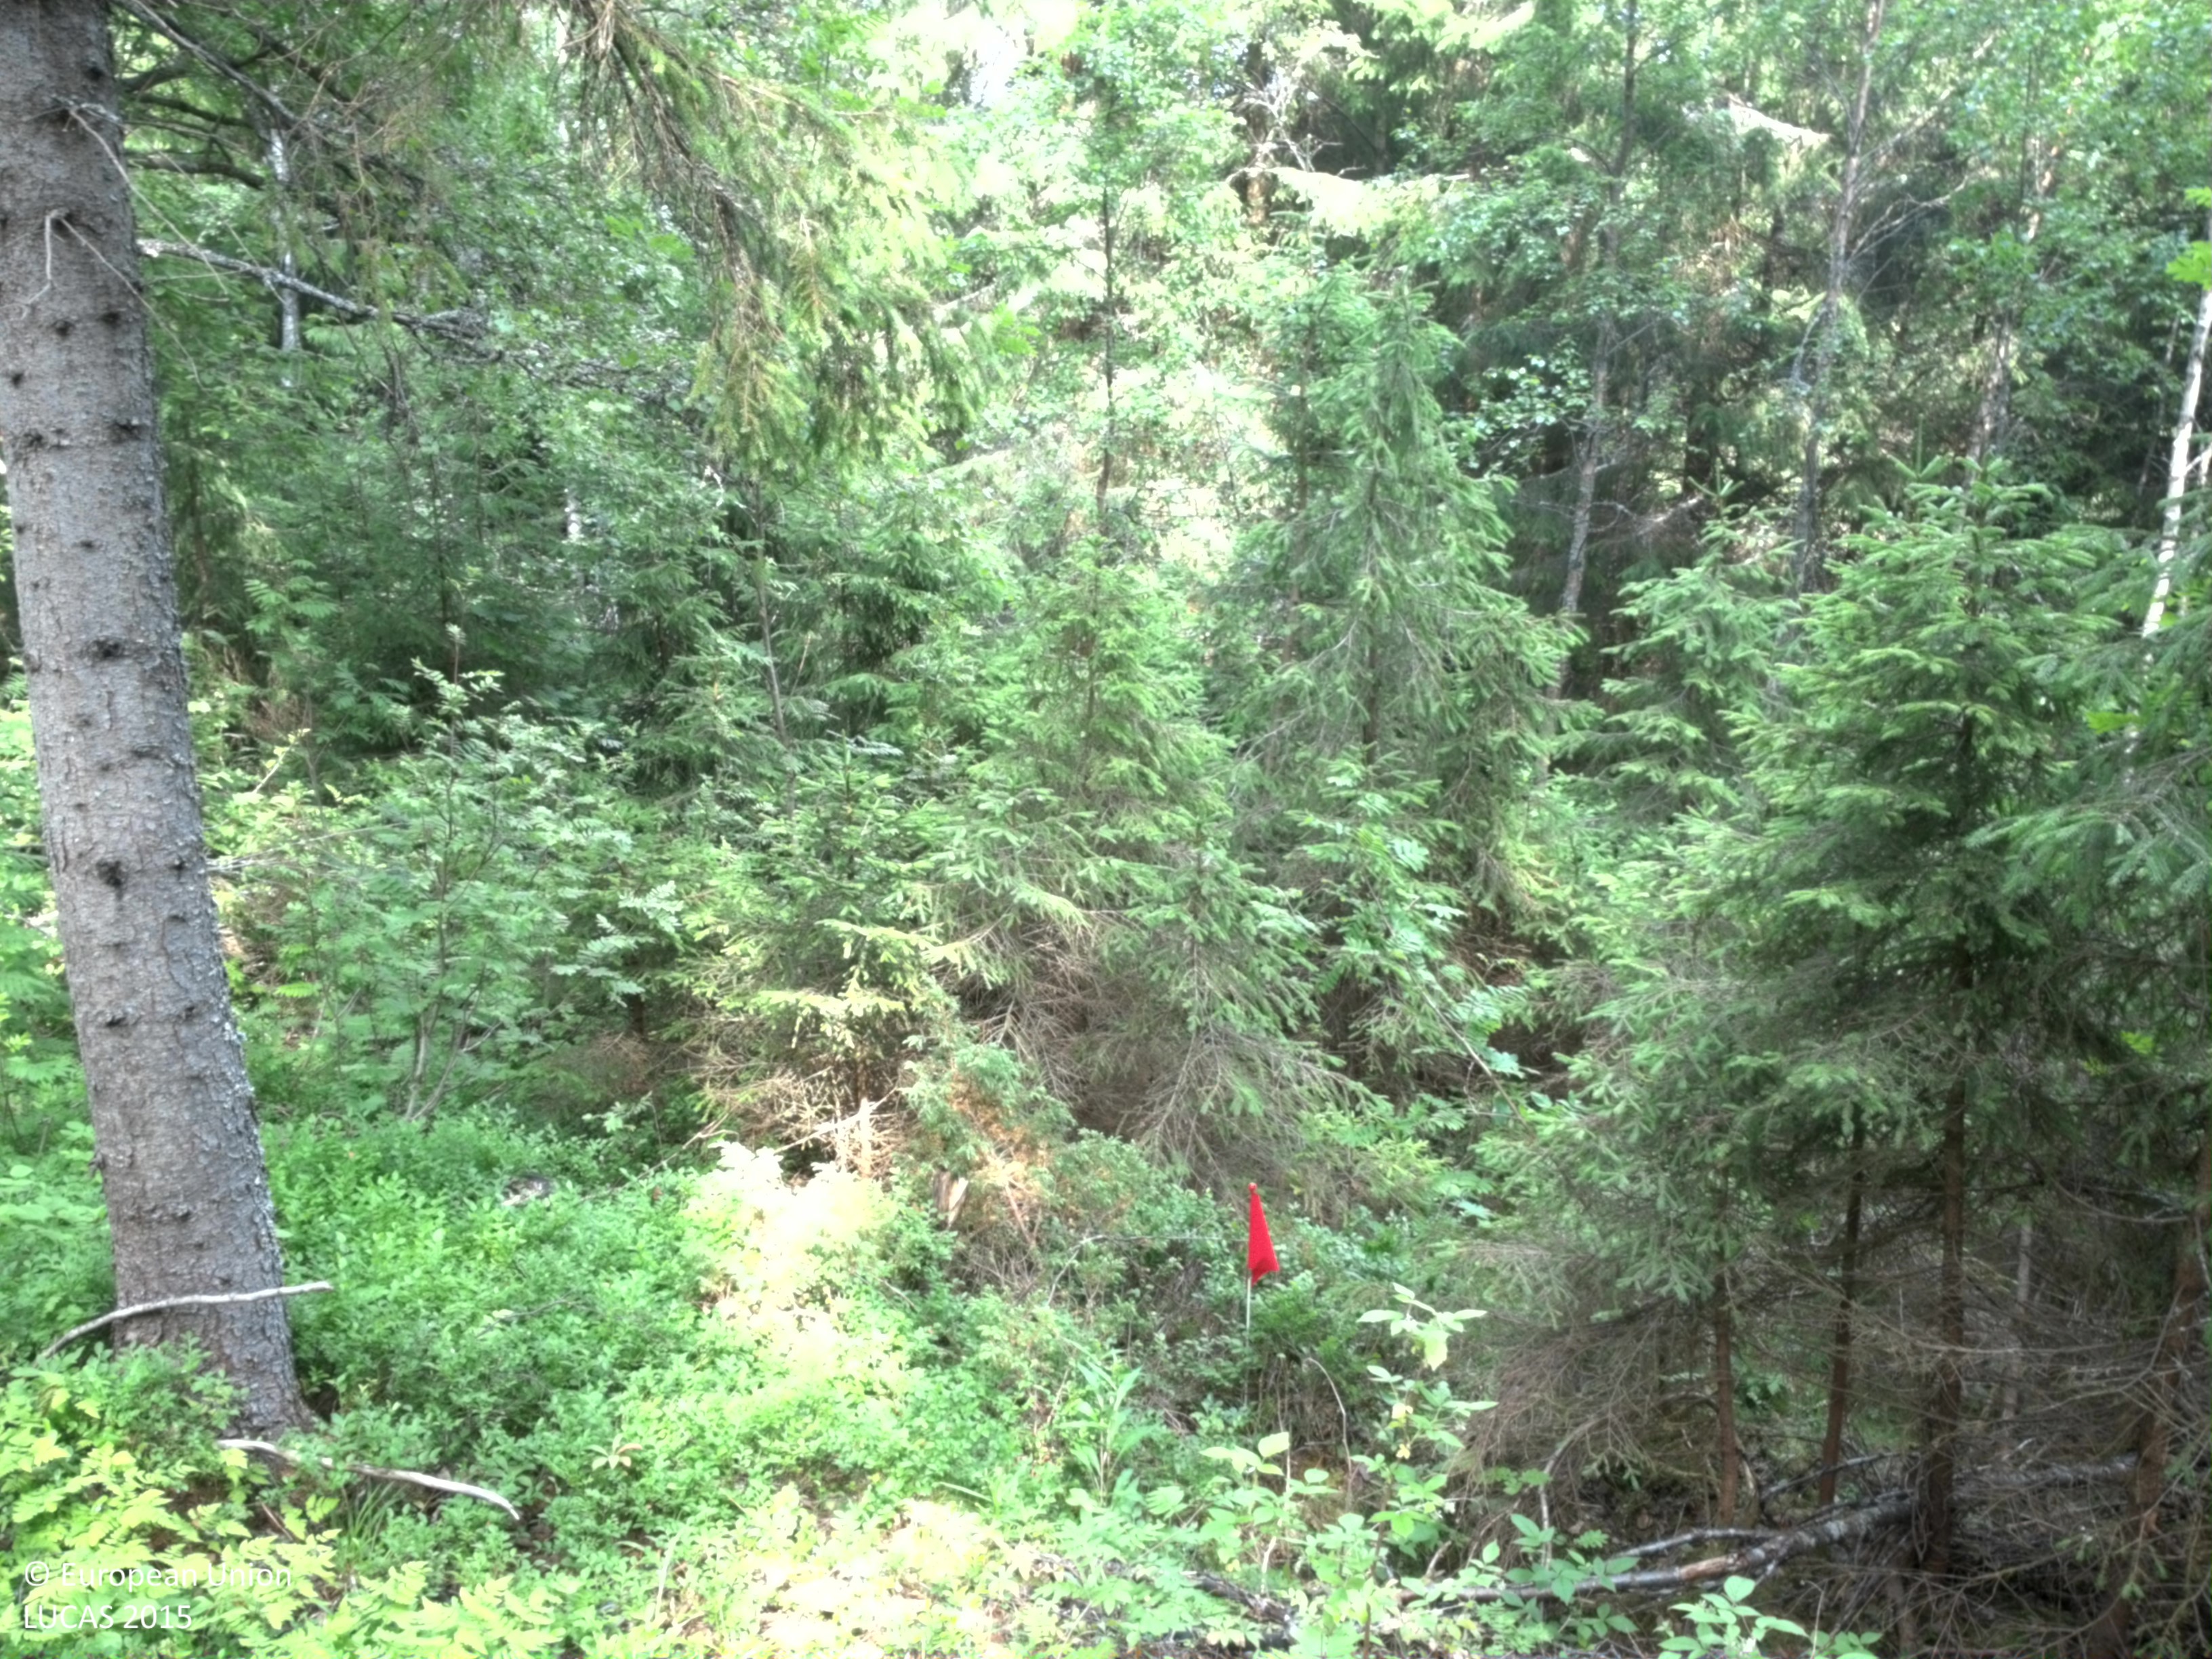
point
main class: Woodland
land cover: Spruce dominated coniferous woodland
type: boreal forest
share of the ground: 50 - 75 %
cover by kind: coniferous forest trees 70 %, shrubs 25 %, broadleaved forest trees 5 %
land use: Forestry
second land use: Amenities, museums, leisure
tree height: > 5 m
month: July
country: SE
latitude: 64.4350
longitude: 21.2614
